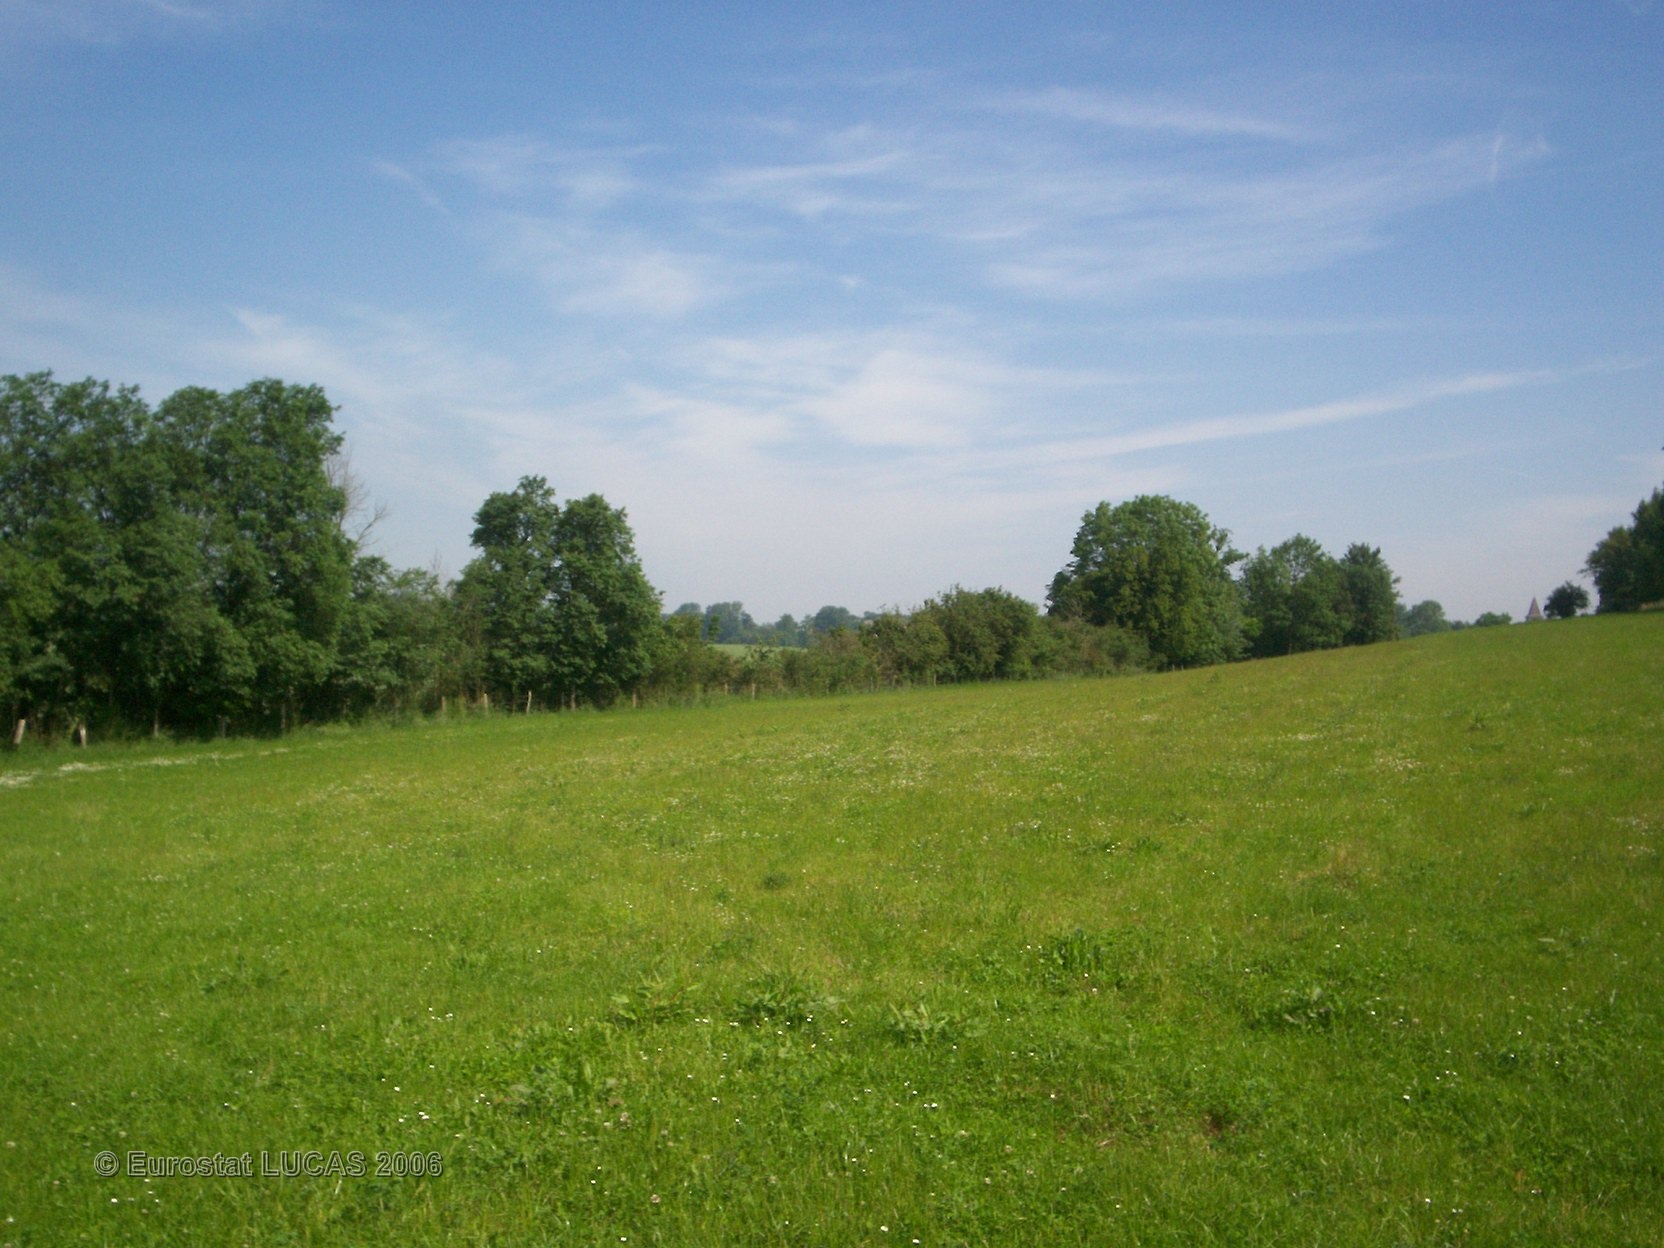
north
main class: Grassland
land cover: Grassland without tree/shrub cover
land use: Agriculture (excluding fallow land and kitchen gardens)
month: June
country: FR
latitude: 49.5710
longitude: 2.7016
